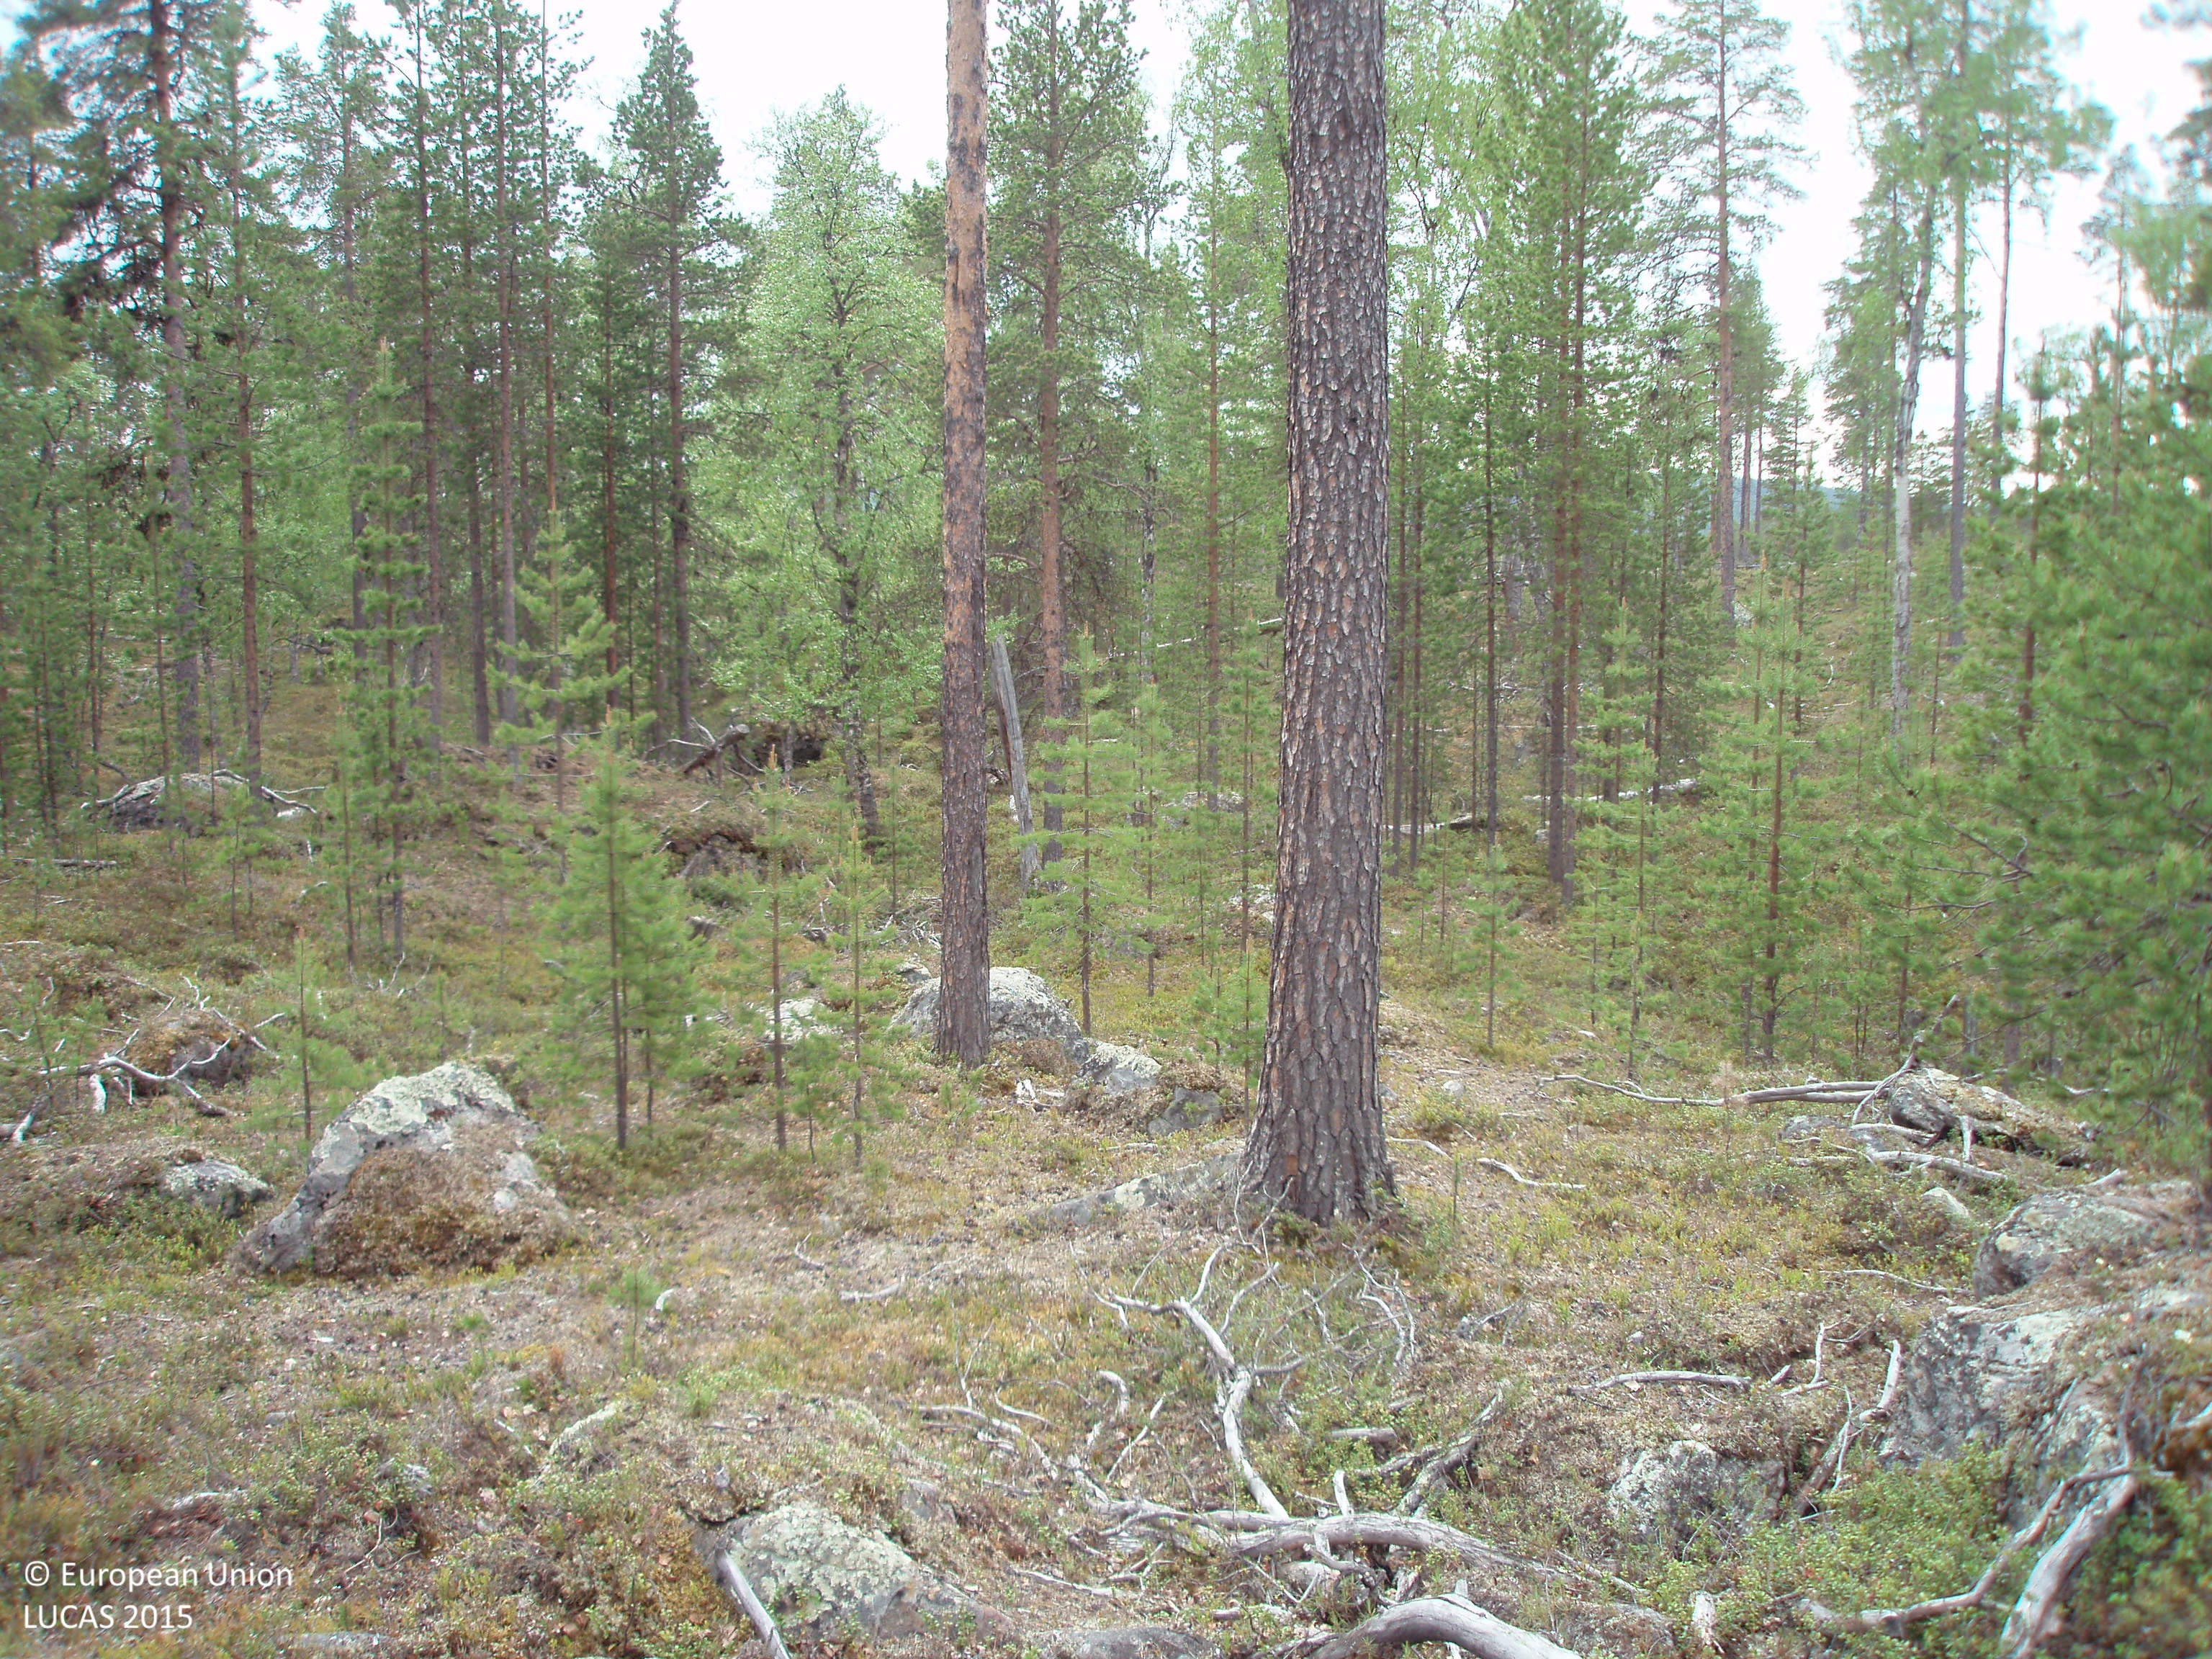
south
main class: Woodland
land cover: Pine dominated coniferous woodland
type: boreal forest
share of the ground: 25 - 50 %
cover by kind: shrubs 55 %, coniferous forest trees 30 %, broadleaved forest trees 5 %, lichens and mosses 5 %, unconsolidated bare surface 5 %
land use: Forestry
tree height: > 5 m
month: June
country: FI
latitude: 68.8054
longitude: 28.1104
